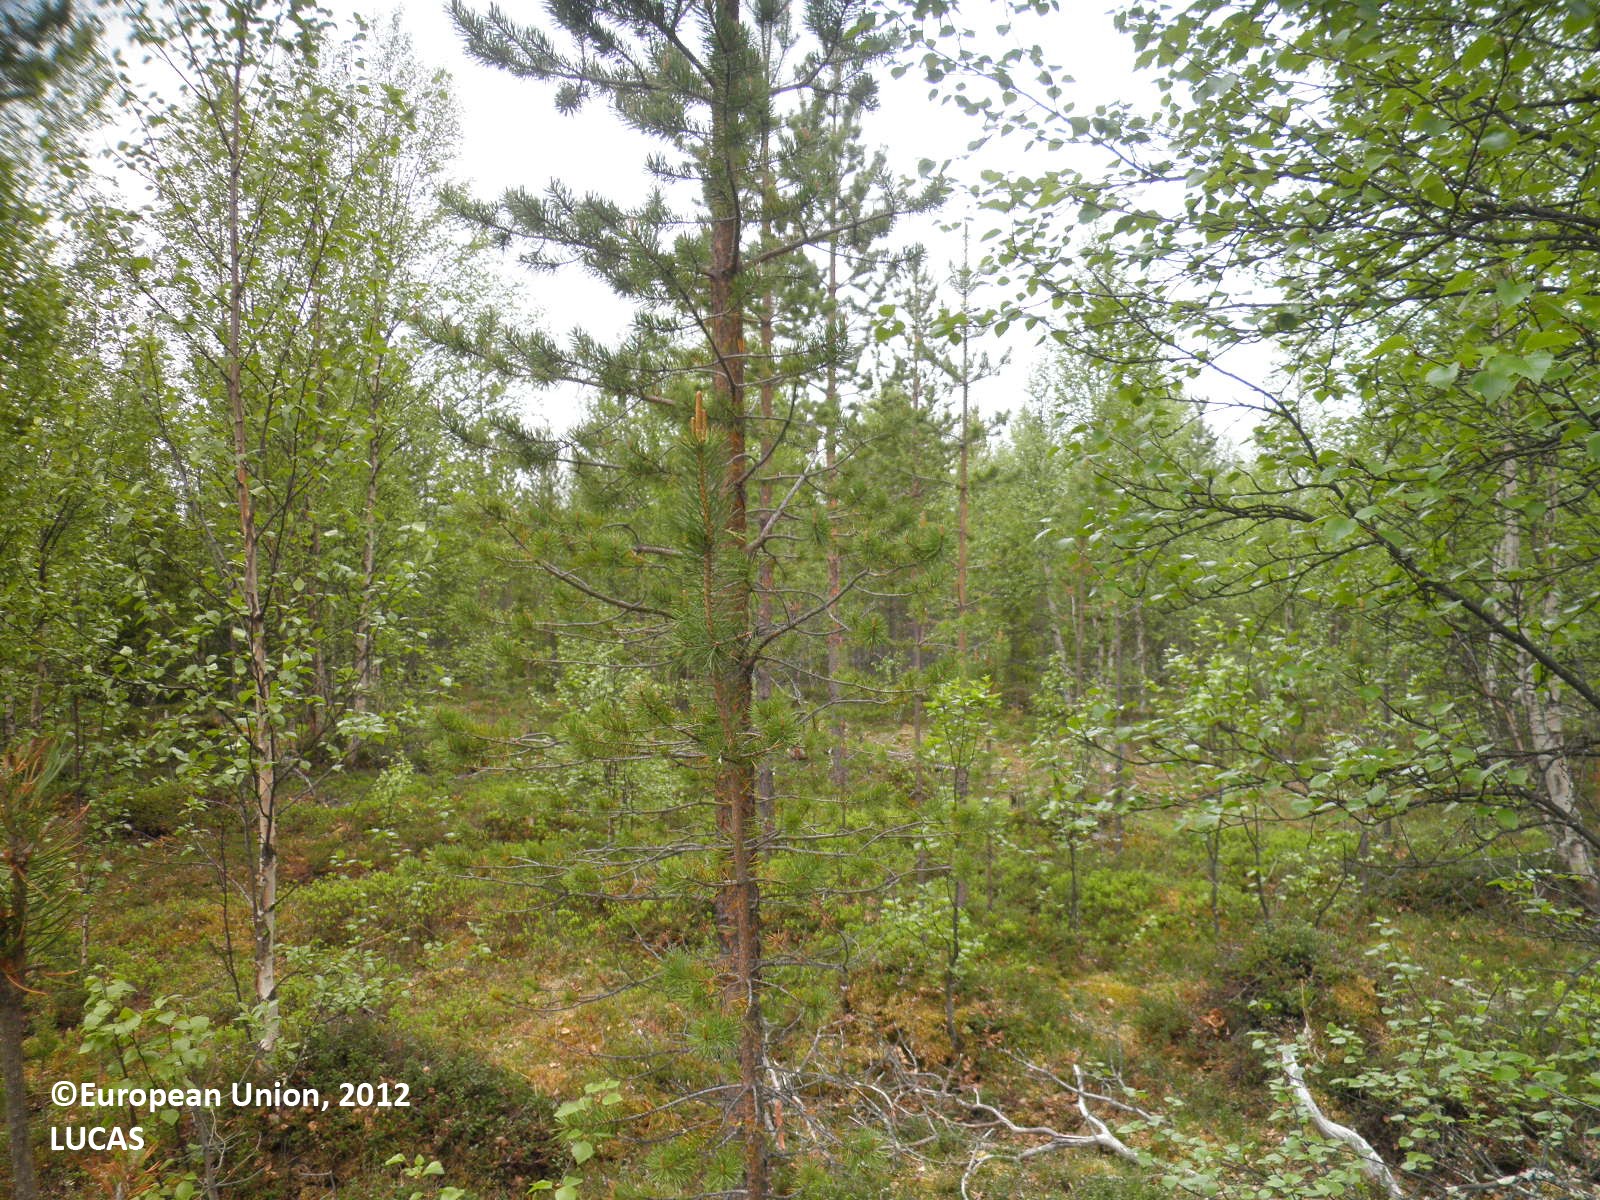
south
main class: Woodland
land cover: Pine dominated mixed woodland
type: boreal forest
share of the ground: 25 - 50 %
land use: Forestry
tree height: < 5 m
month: June
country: FI
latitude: 67.8407
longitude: 25.6557
